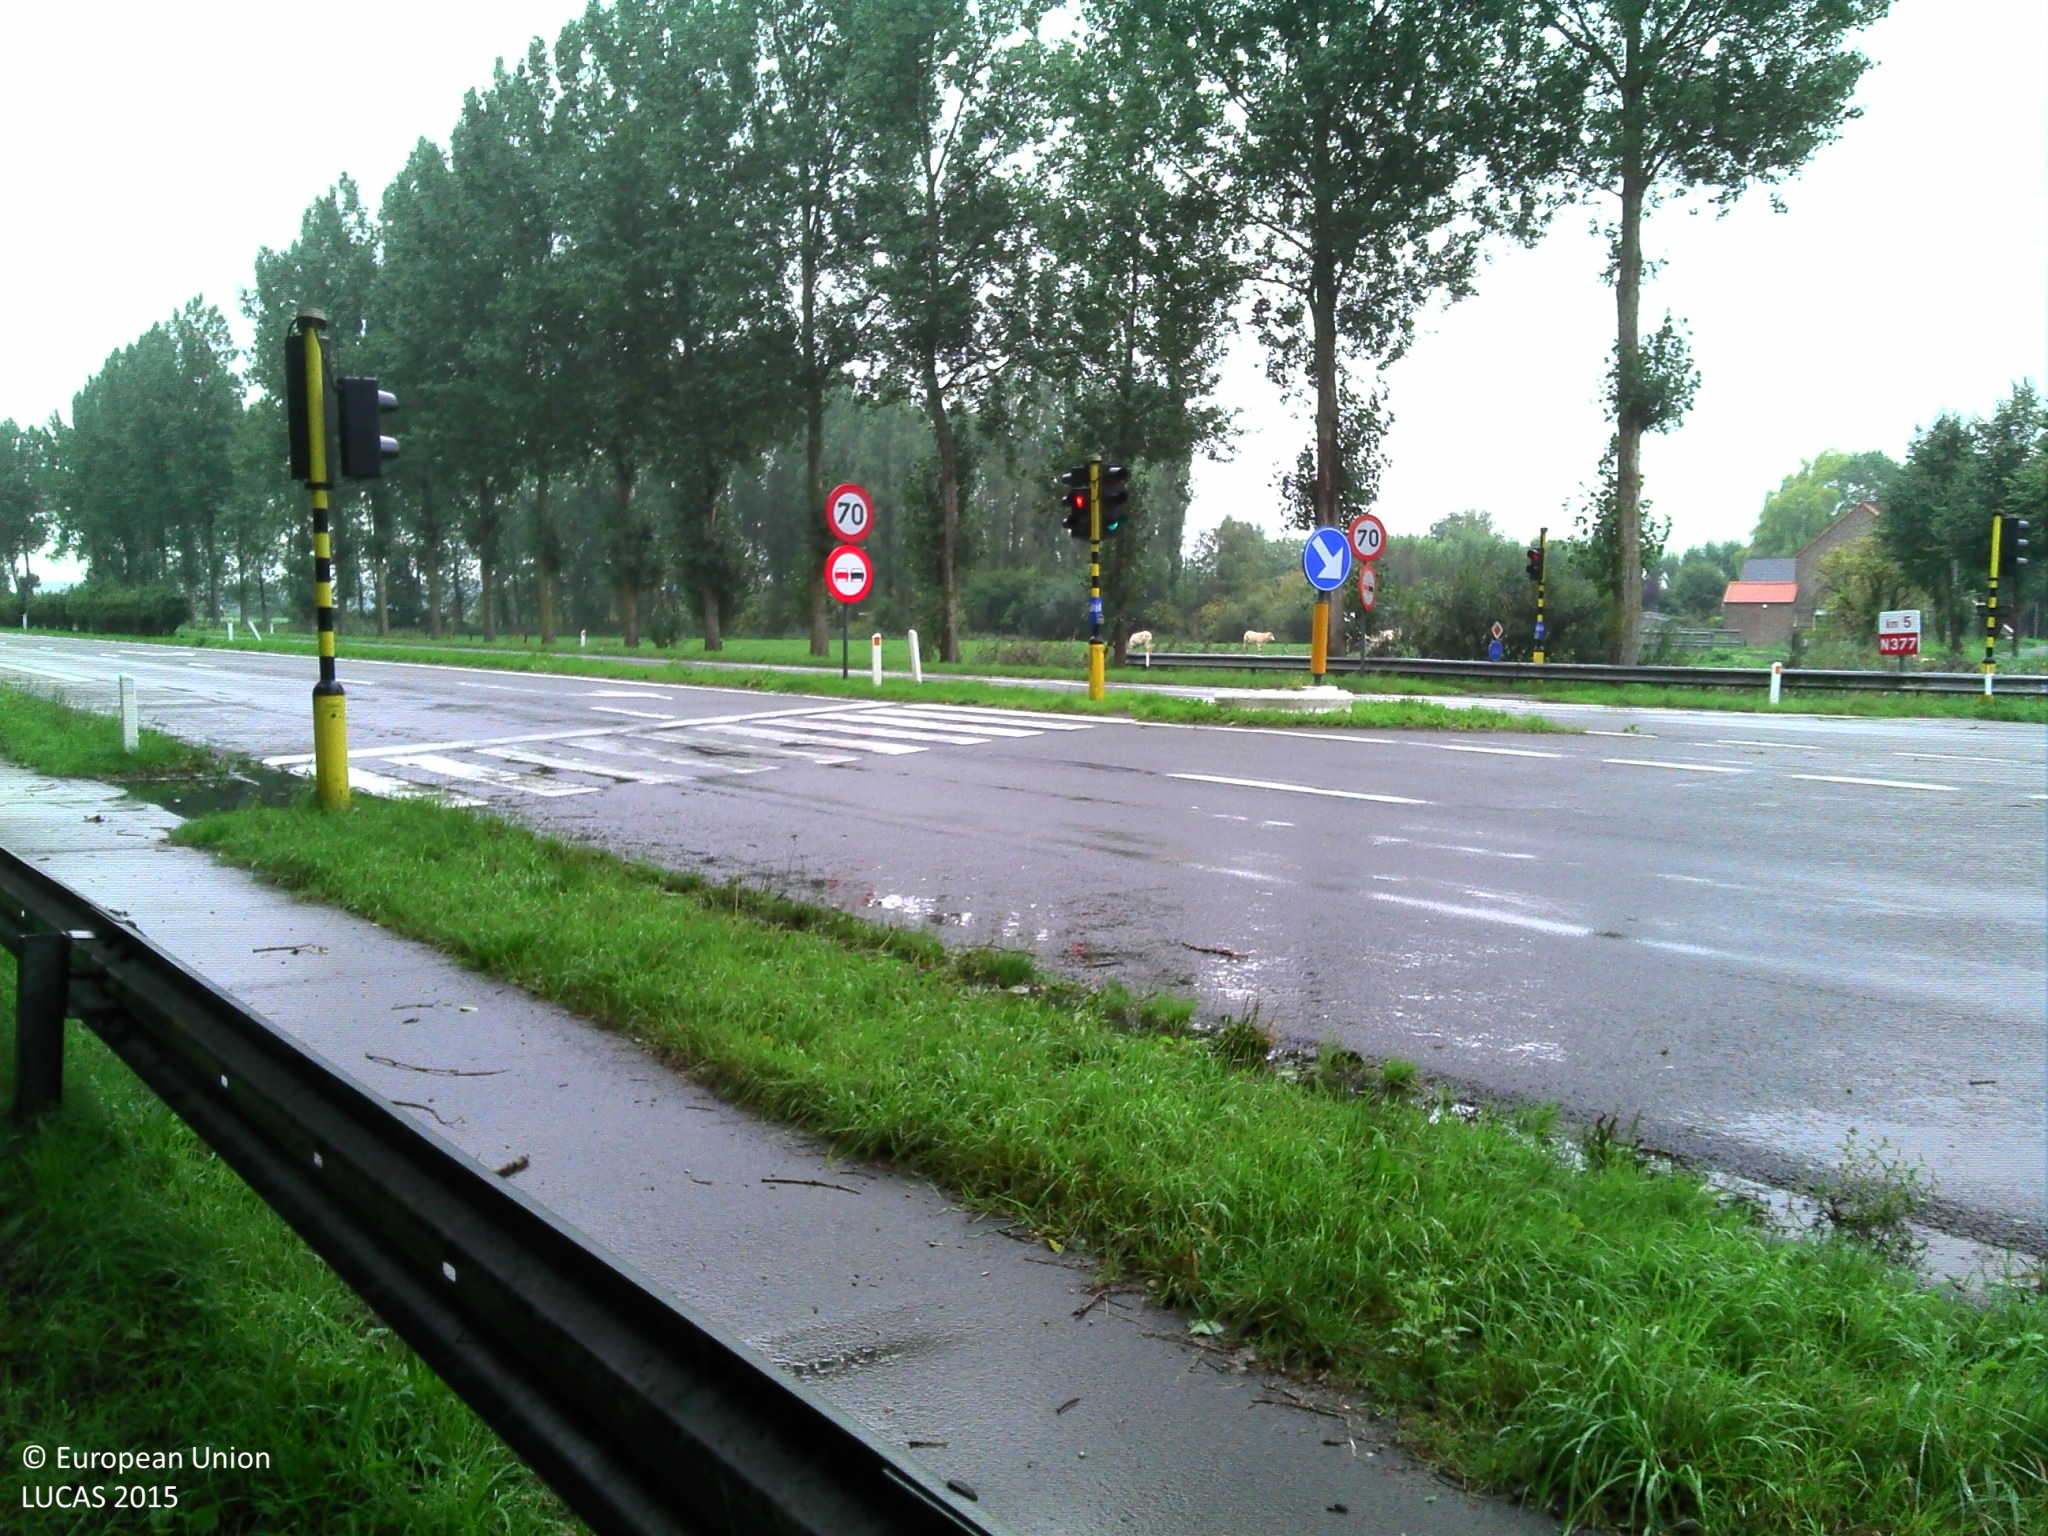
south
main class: Woodland
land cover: Broadleaved woodland
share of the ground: > 75 %
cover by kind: broadleaved forest trees 90 %, herbaceous plants 10 %
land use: Road transport
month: September
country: BE
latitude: 51.2189
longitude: 3.0750
